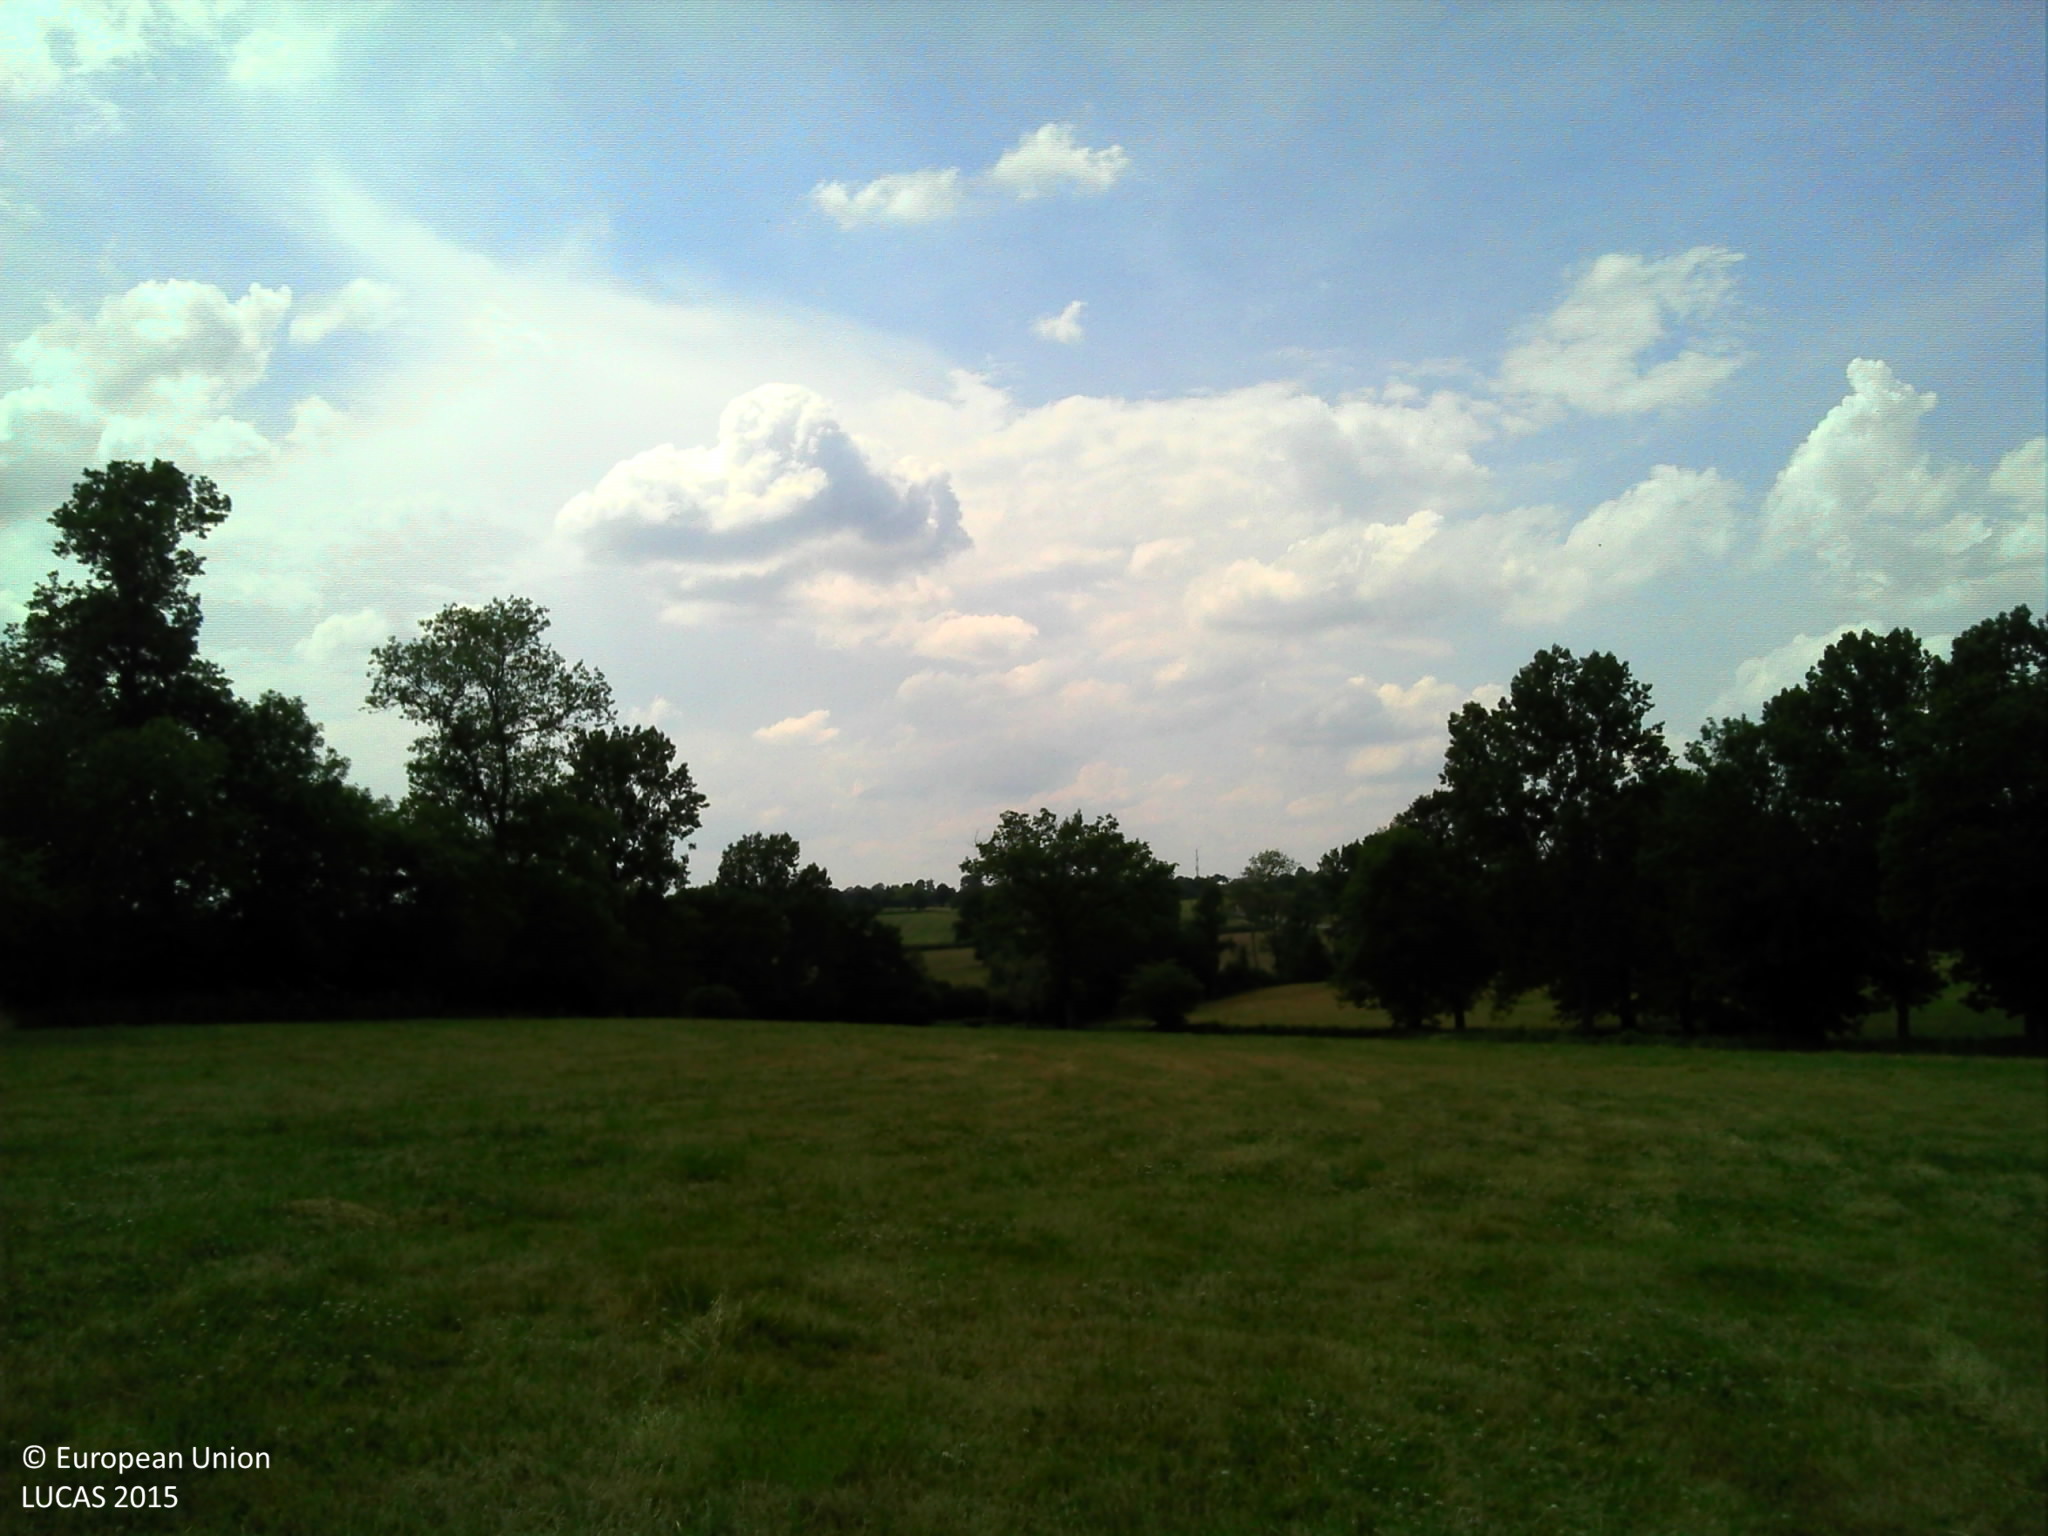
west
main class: Cropland
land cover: Temporary grasslands
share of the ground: > 75 %
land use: Agriculture (excluding fallow land and kitchen gardens)
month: June
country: FR
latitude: 46.3204
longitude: 2.9974
